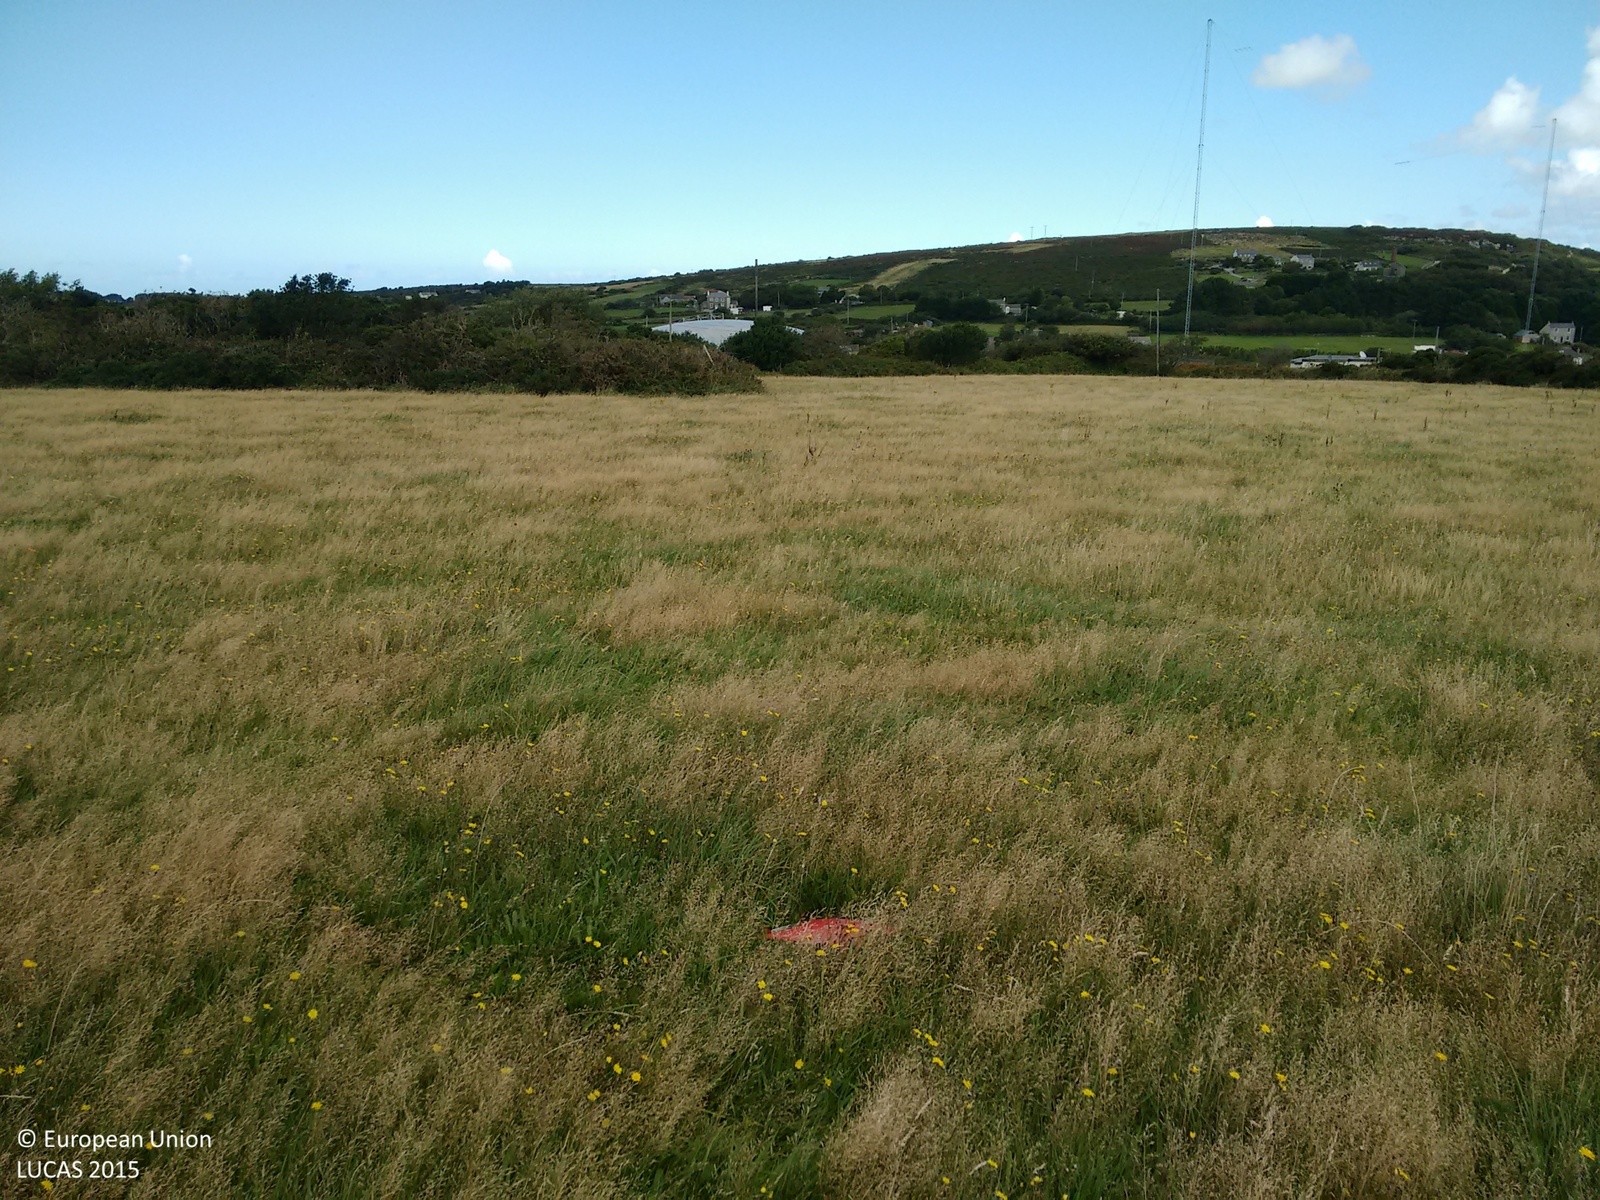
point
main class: Grassland
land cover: Grassland without tree/shrub cover
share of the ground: > 75 %
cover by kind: herbaceous plants 100 %
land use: Agriculture (excluding fallow land and kitchen gardens)
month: August
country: GB
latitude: 50.2169
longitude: -5.2142
